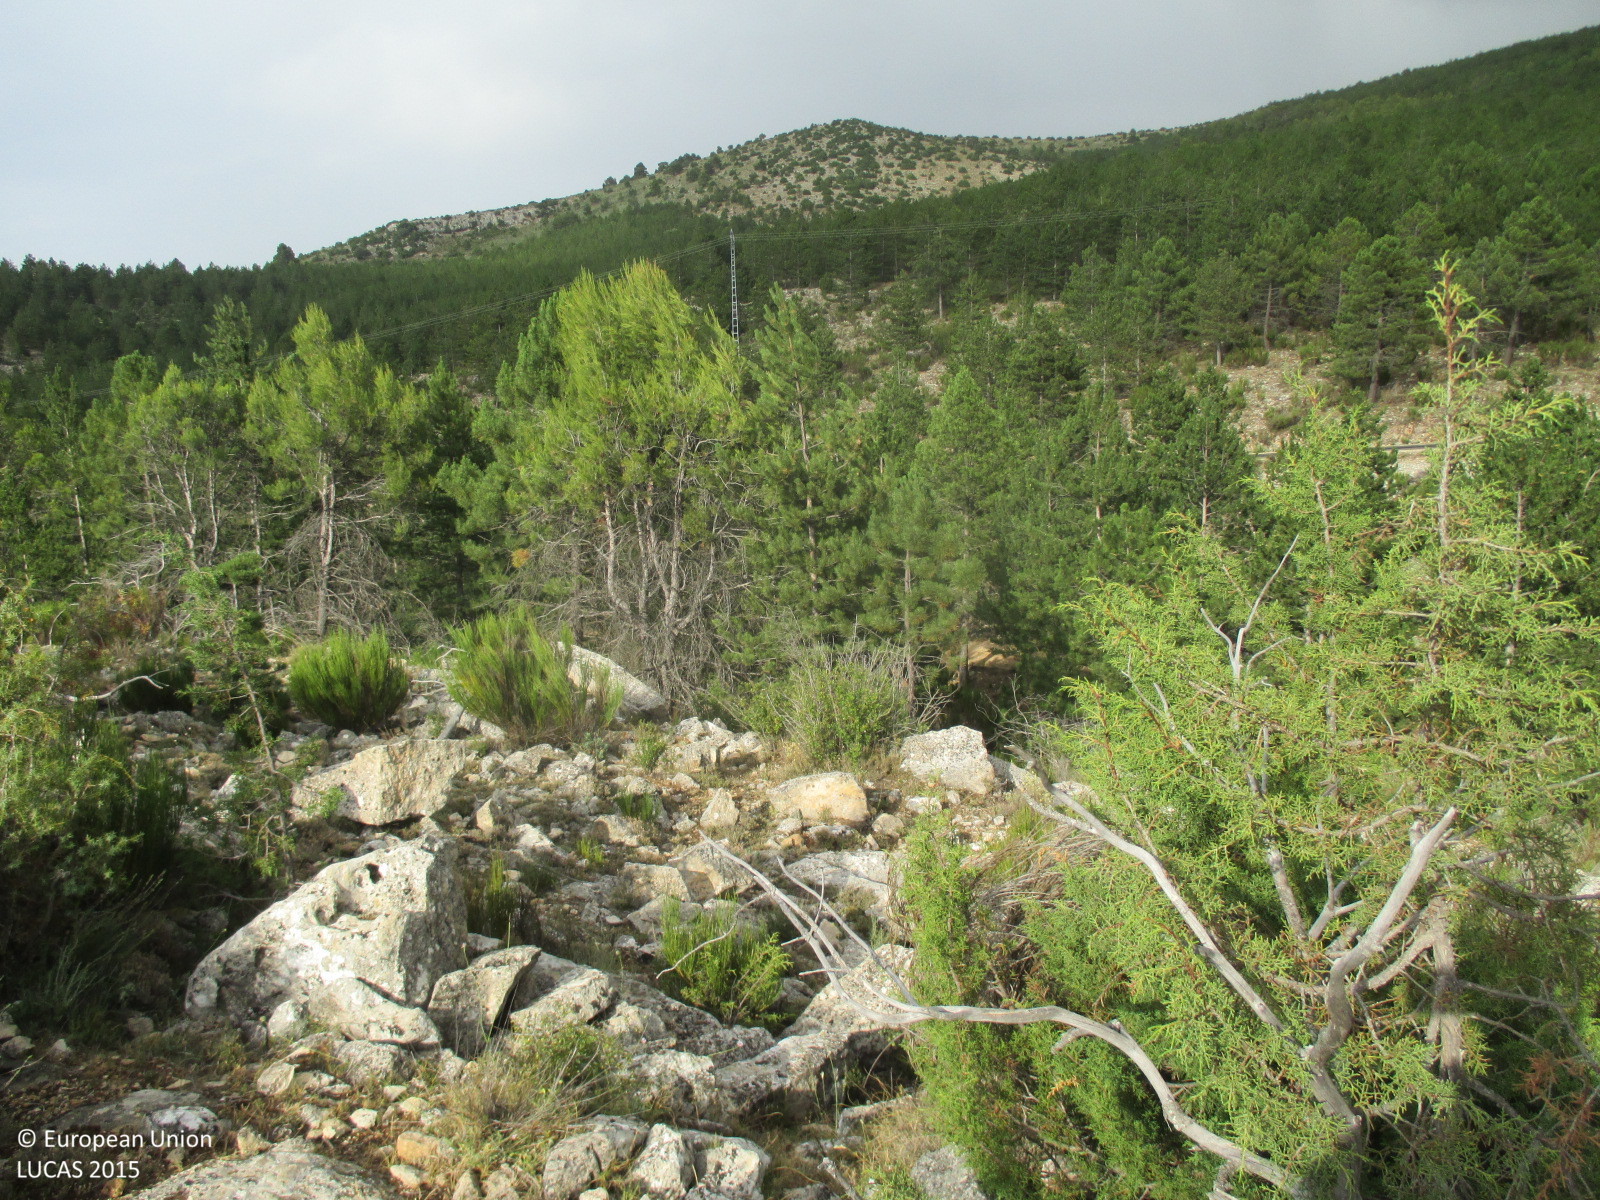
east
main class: Shrubland
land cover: Shrubland with sparse tree cover
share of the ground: 50 - 75 %
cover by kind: shrubs 60 %, herbaceous plants 35 %, coniferous forest trees 5 %
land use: Semi-natural and natural areas not in use
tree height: < 5 m
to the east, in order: Shrubland with sparse tree cover; Pine dominated coniferous woodland; Tracks; Pine dominated coniferous woodland; Paved roads, cycling and walking lanes; Pine dominated coniferous woodland; Shrubland without tree cover; Electric lines; Shrubland without tree cover; Pine dominated coniferous woodland
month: July
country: ES
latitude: 38.1571
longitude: -2.4219
